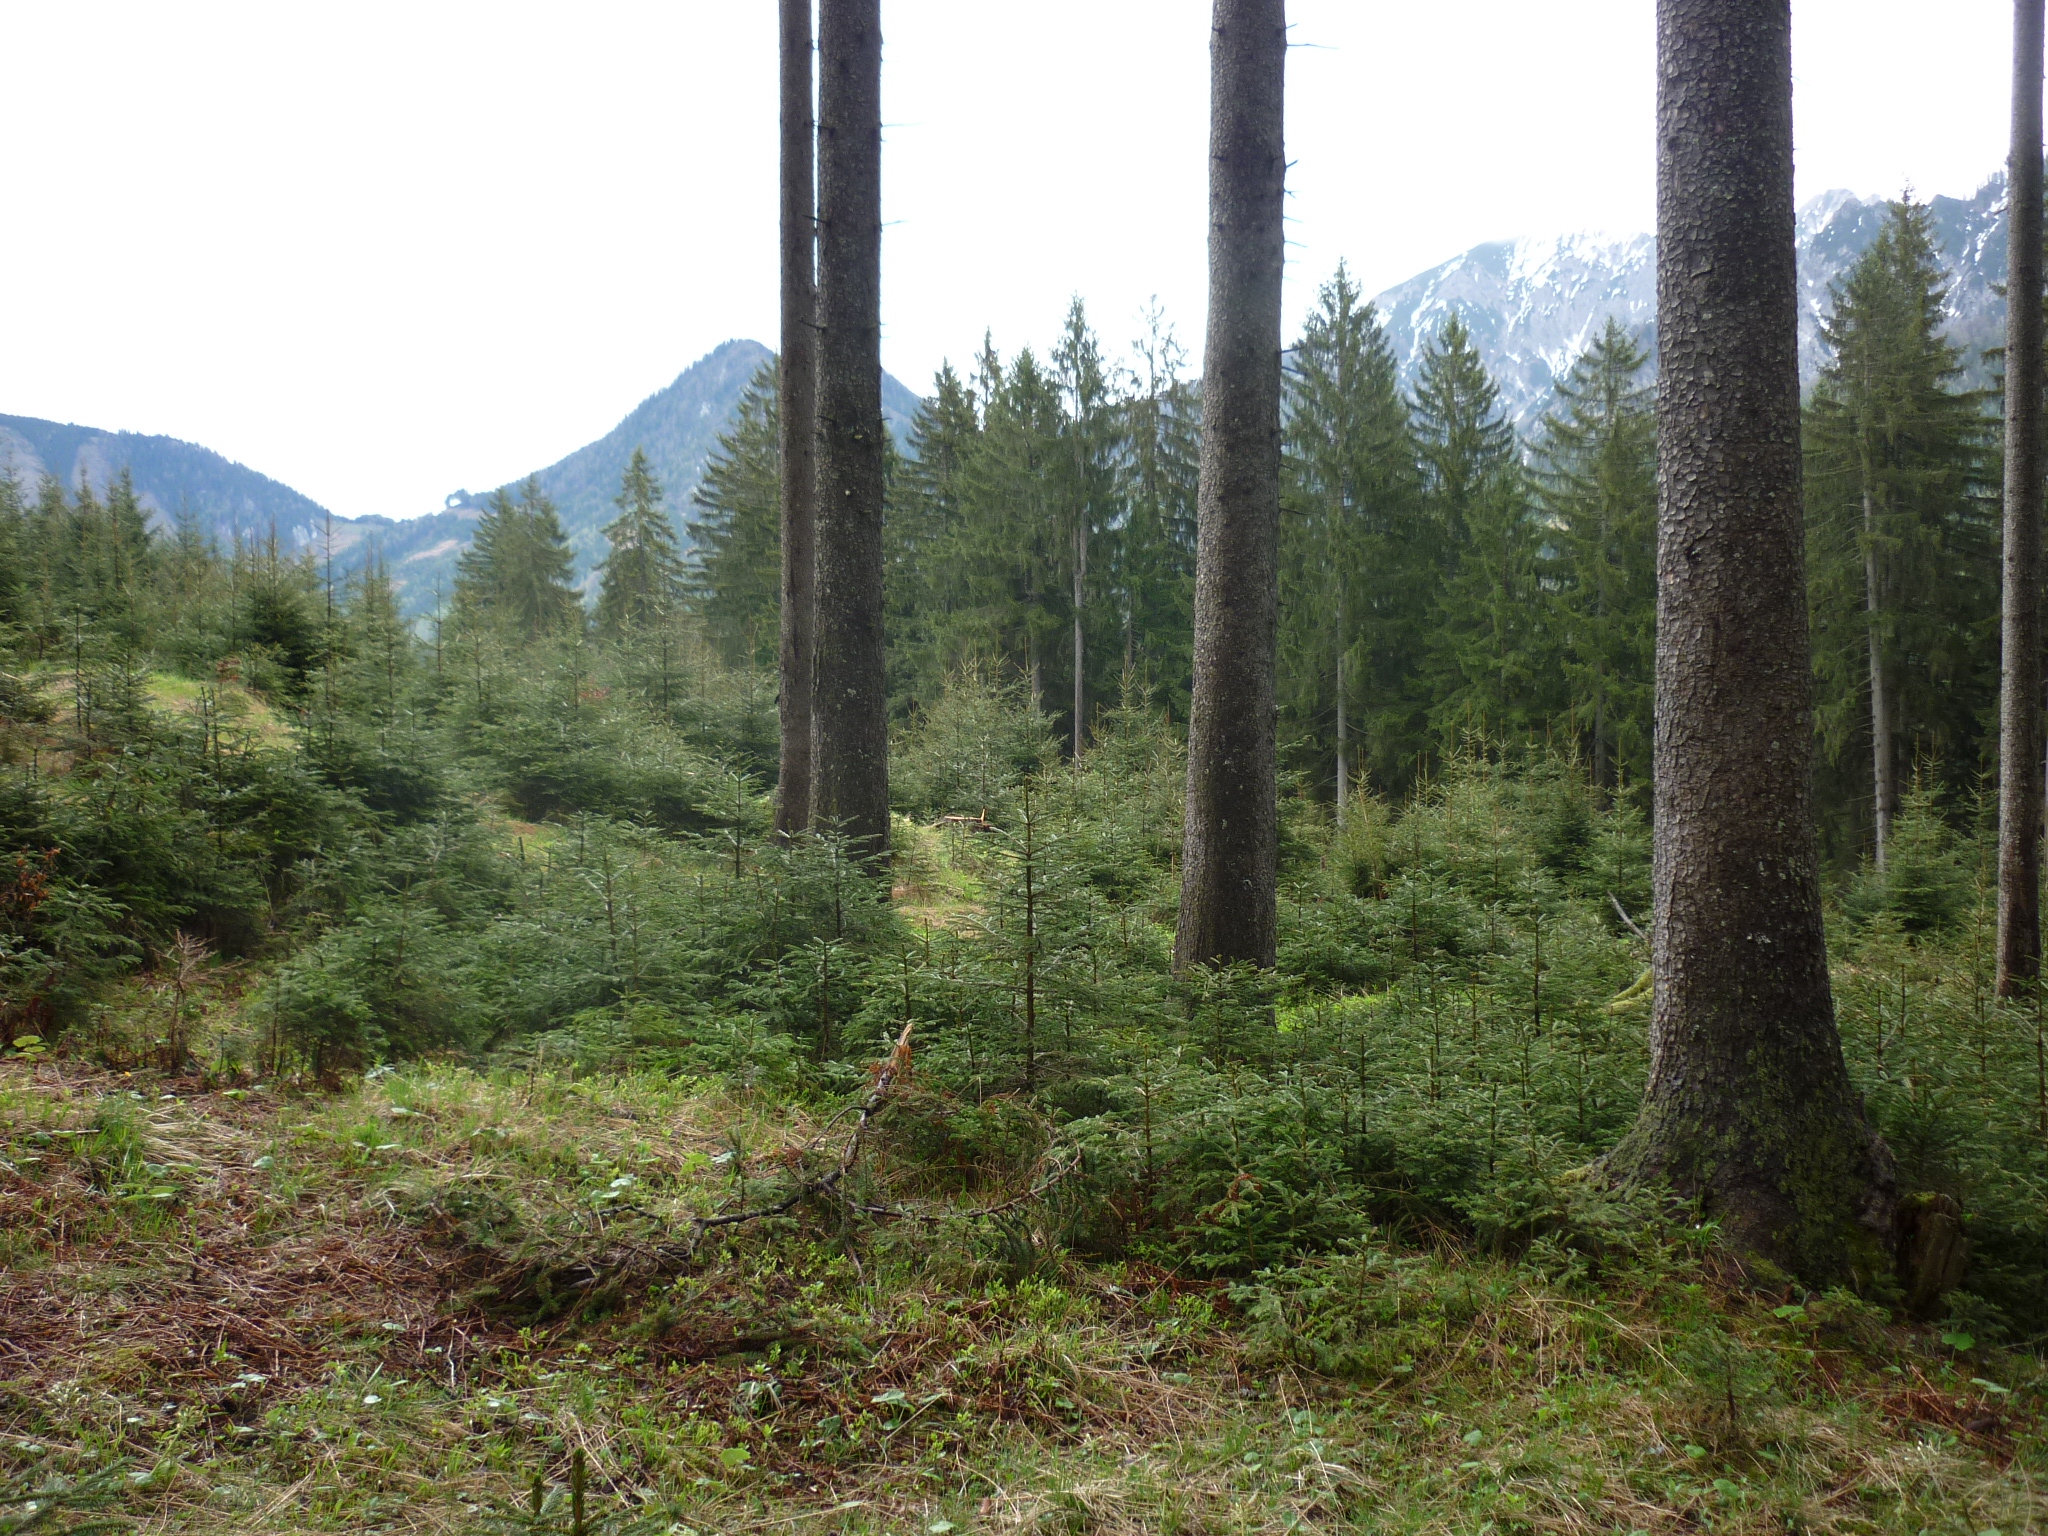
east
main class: Woodland
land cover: Spruce dominated coniferous woodland
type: alpine coniferous forest
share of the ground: 50 - 75 %
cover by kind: coniferous forest trees 70 %, herbaceous plants 20 %, lichens and mosses 10 %
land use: Forestry
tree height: > 5 m
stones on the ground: < 10 %
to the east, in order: Spruce dominated coniferous woodland; Tracks; Spruce dominated coniferous woodland; Grassland with sparse tree/shrub cover
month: May
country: AT
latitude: 47.6424
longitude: 14.5652
